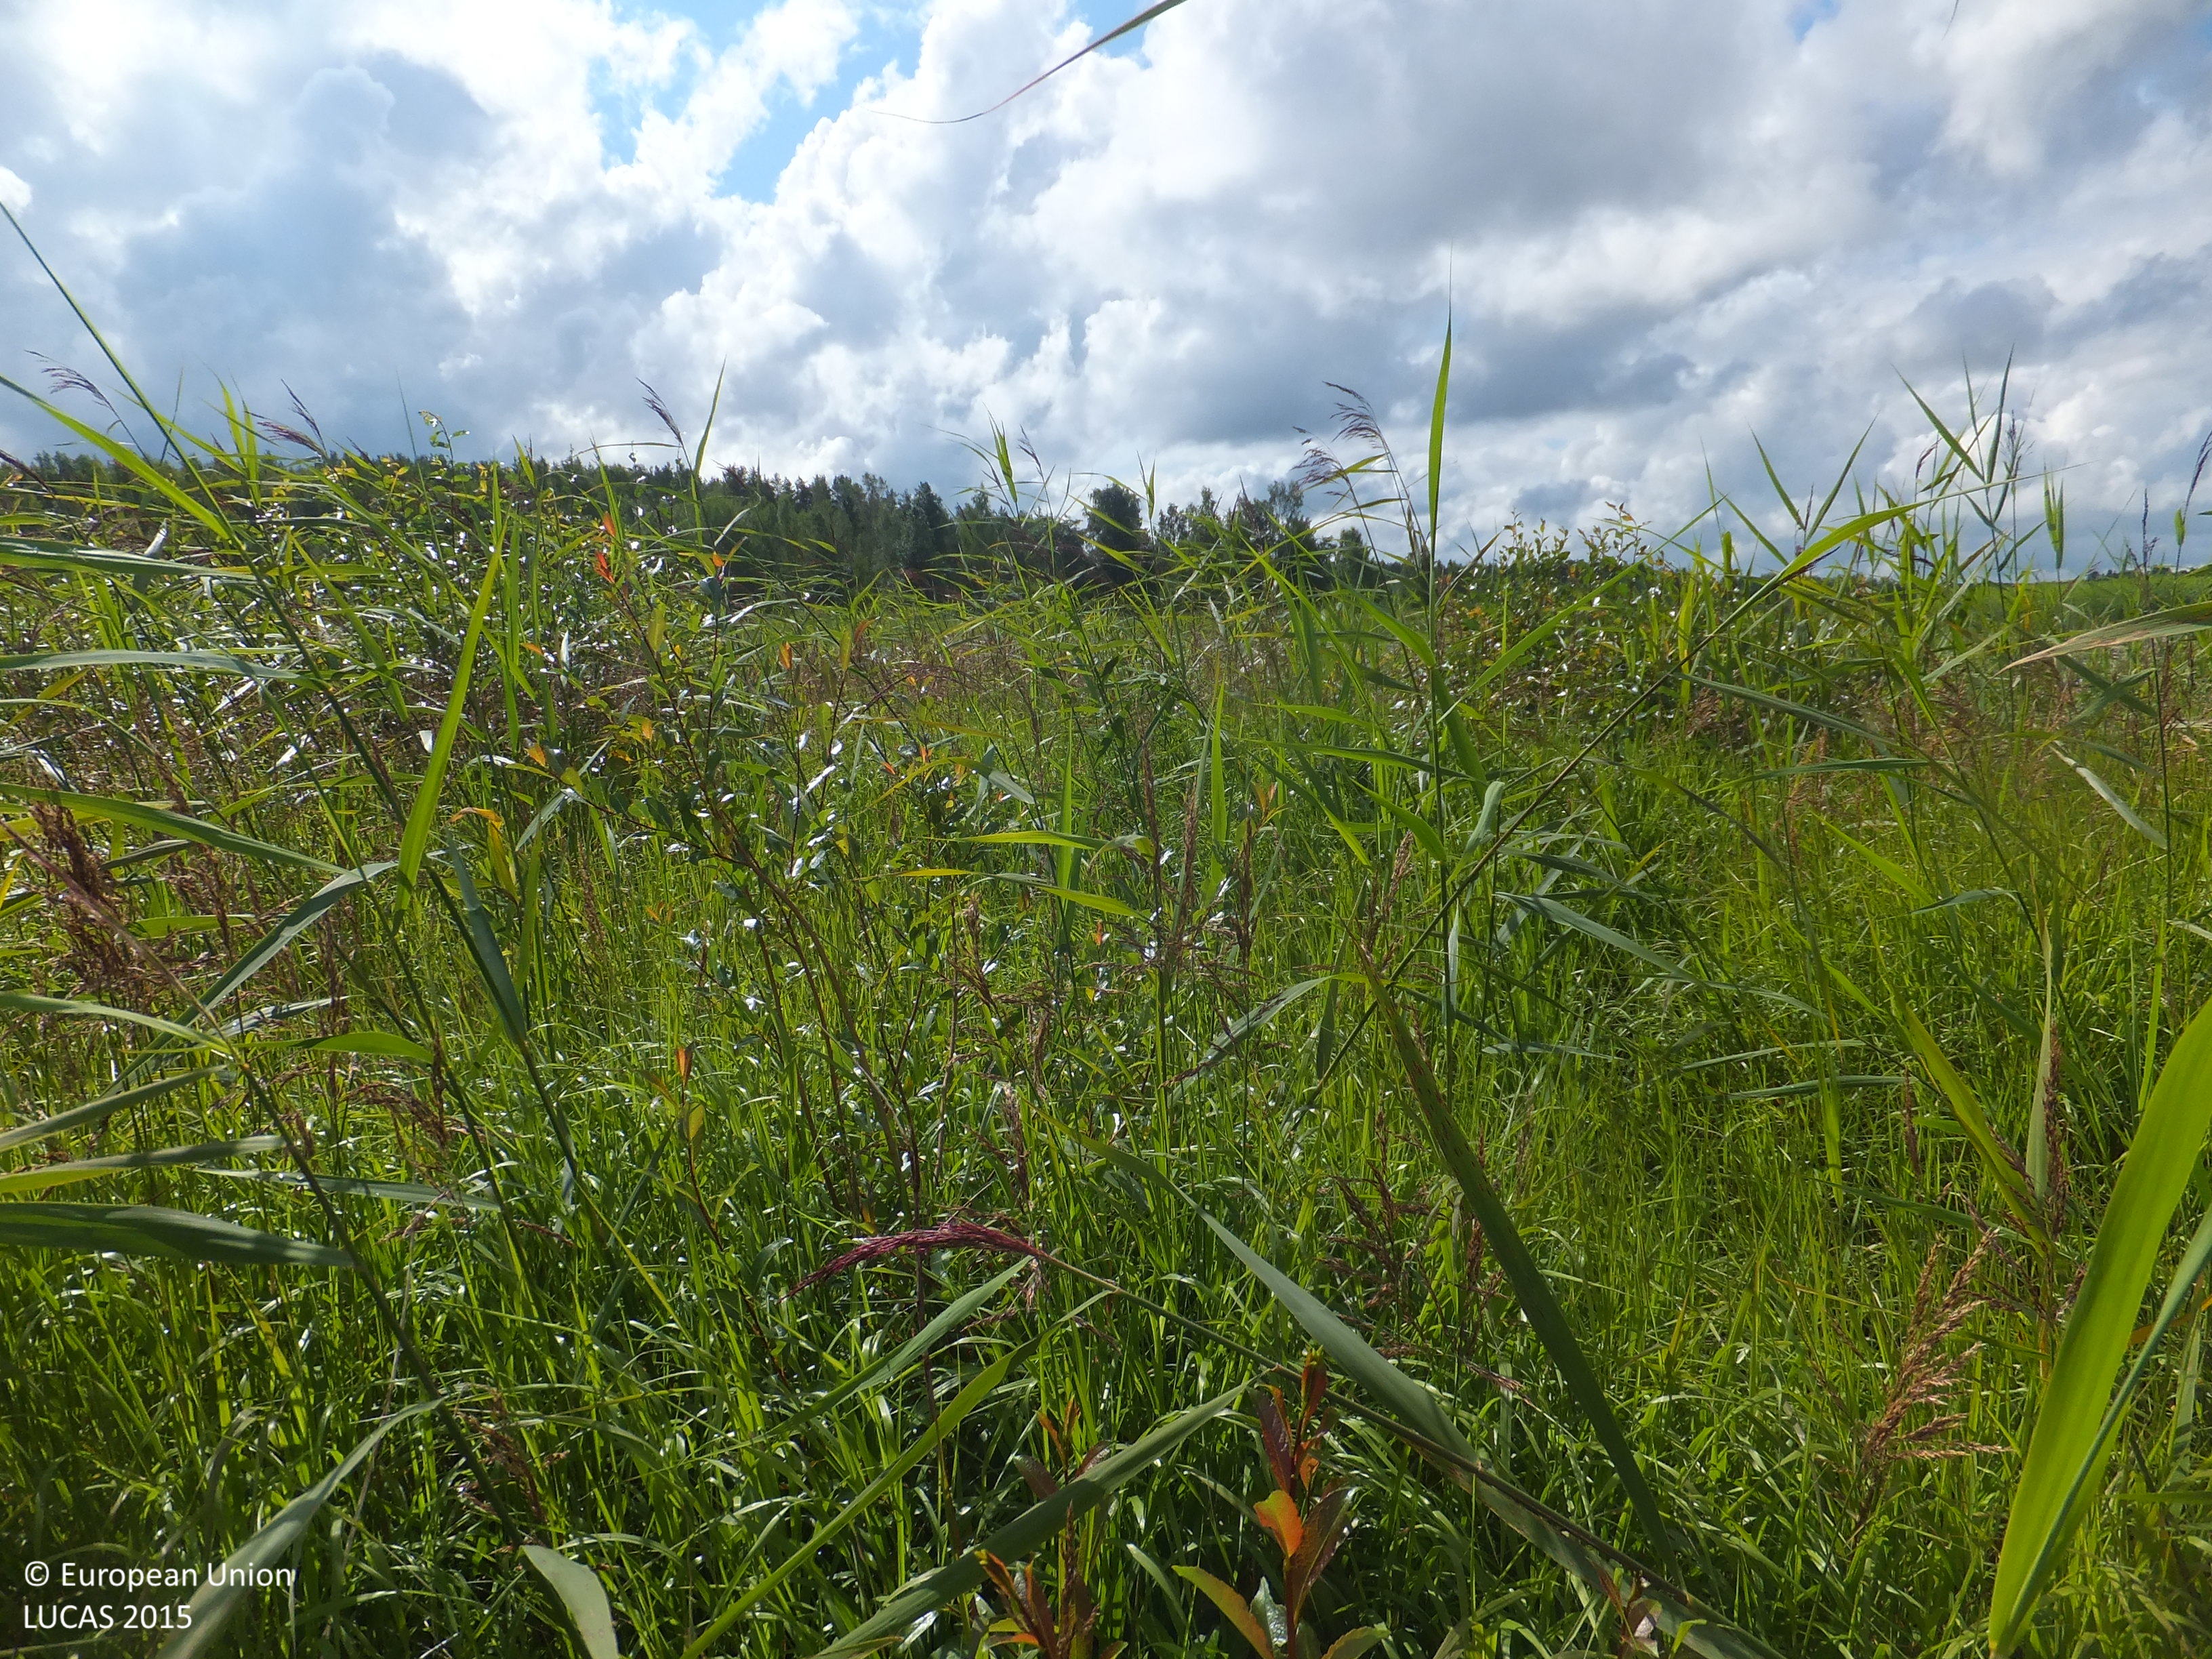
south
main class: Grassland
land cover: Grassland without tree/shrub cover
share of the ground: > 75 %
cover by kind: herbaceous plants 100 %
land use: Semi-natural and natural areas not in use
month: July
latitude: 63.2243
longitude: 22.0414
